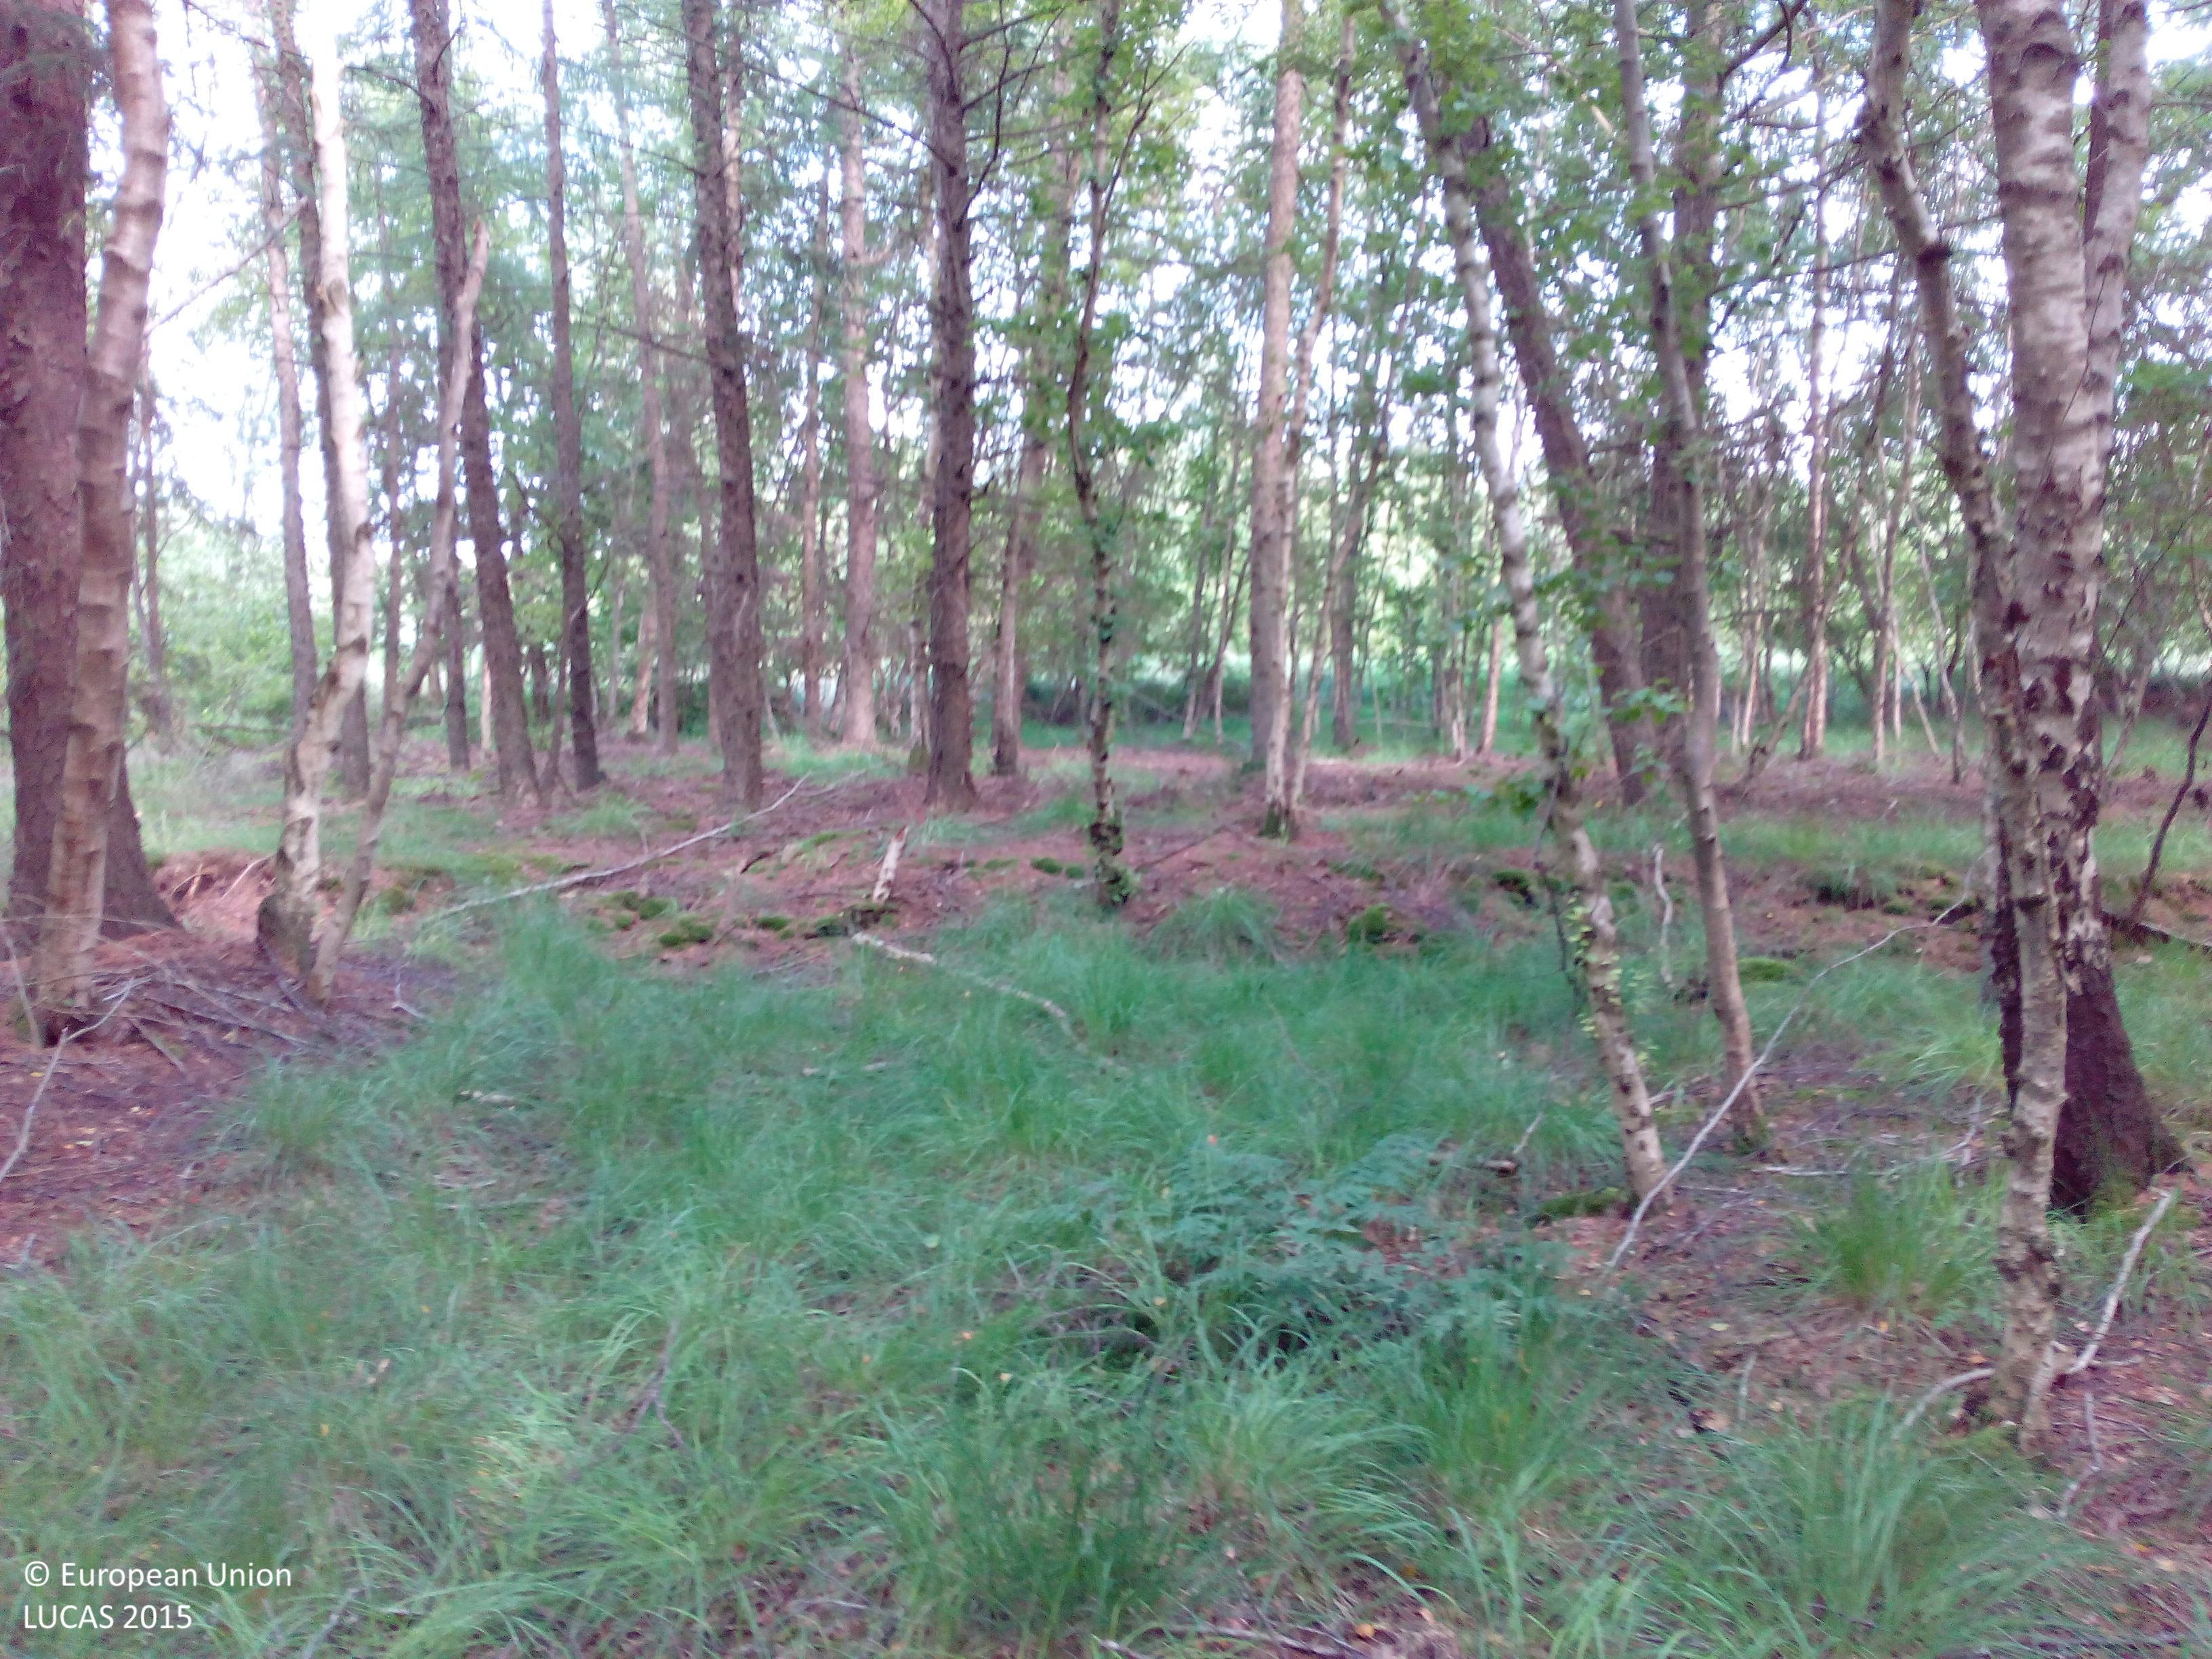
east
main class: Woodland
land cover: Broadleaved woodland
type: mire and swamp forests
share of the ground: > 75 %
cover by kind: broadleaved forest trees 85 %, coniferous forest trees 15 %
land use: Semi-natural and natural areas not in use
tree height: > 5 m
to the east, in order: Broadleaved woodland; Tracks; Grassland without tree/shrub cover; Ditches and canals; Grass margins; Maize; Ditches and canals; Broadleaved woodland; Inland fresh running water
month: July
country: DE
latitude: 53.0426
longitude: 7.9274
